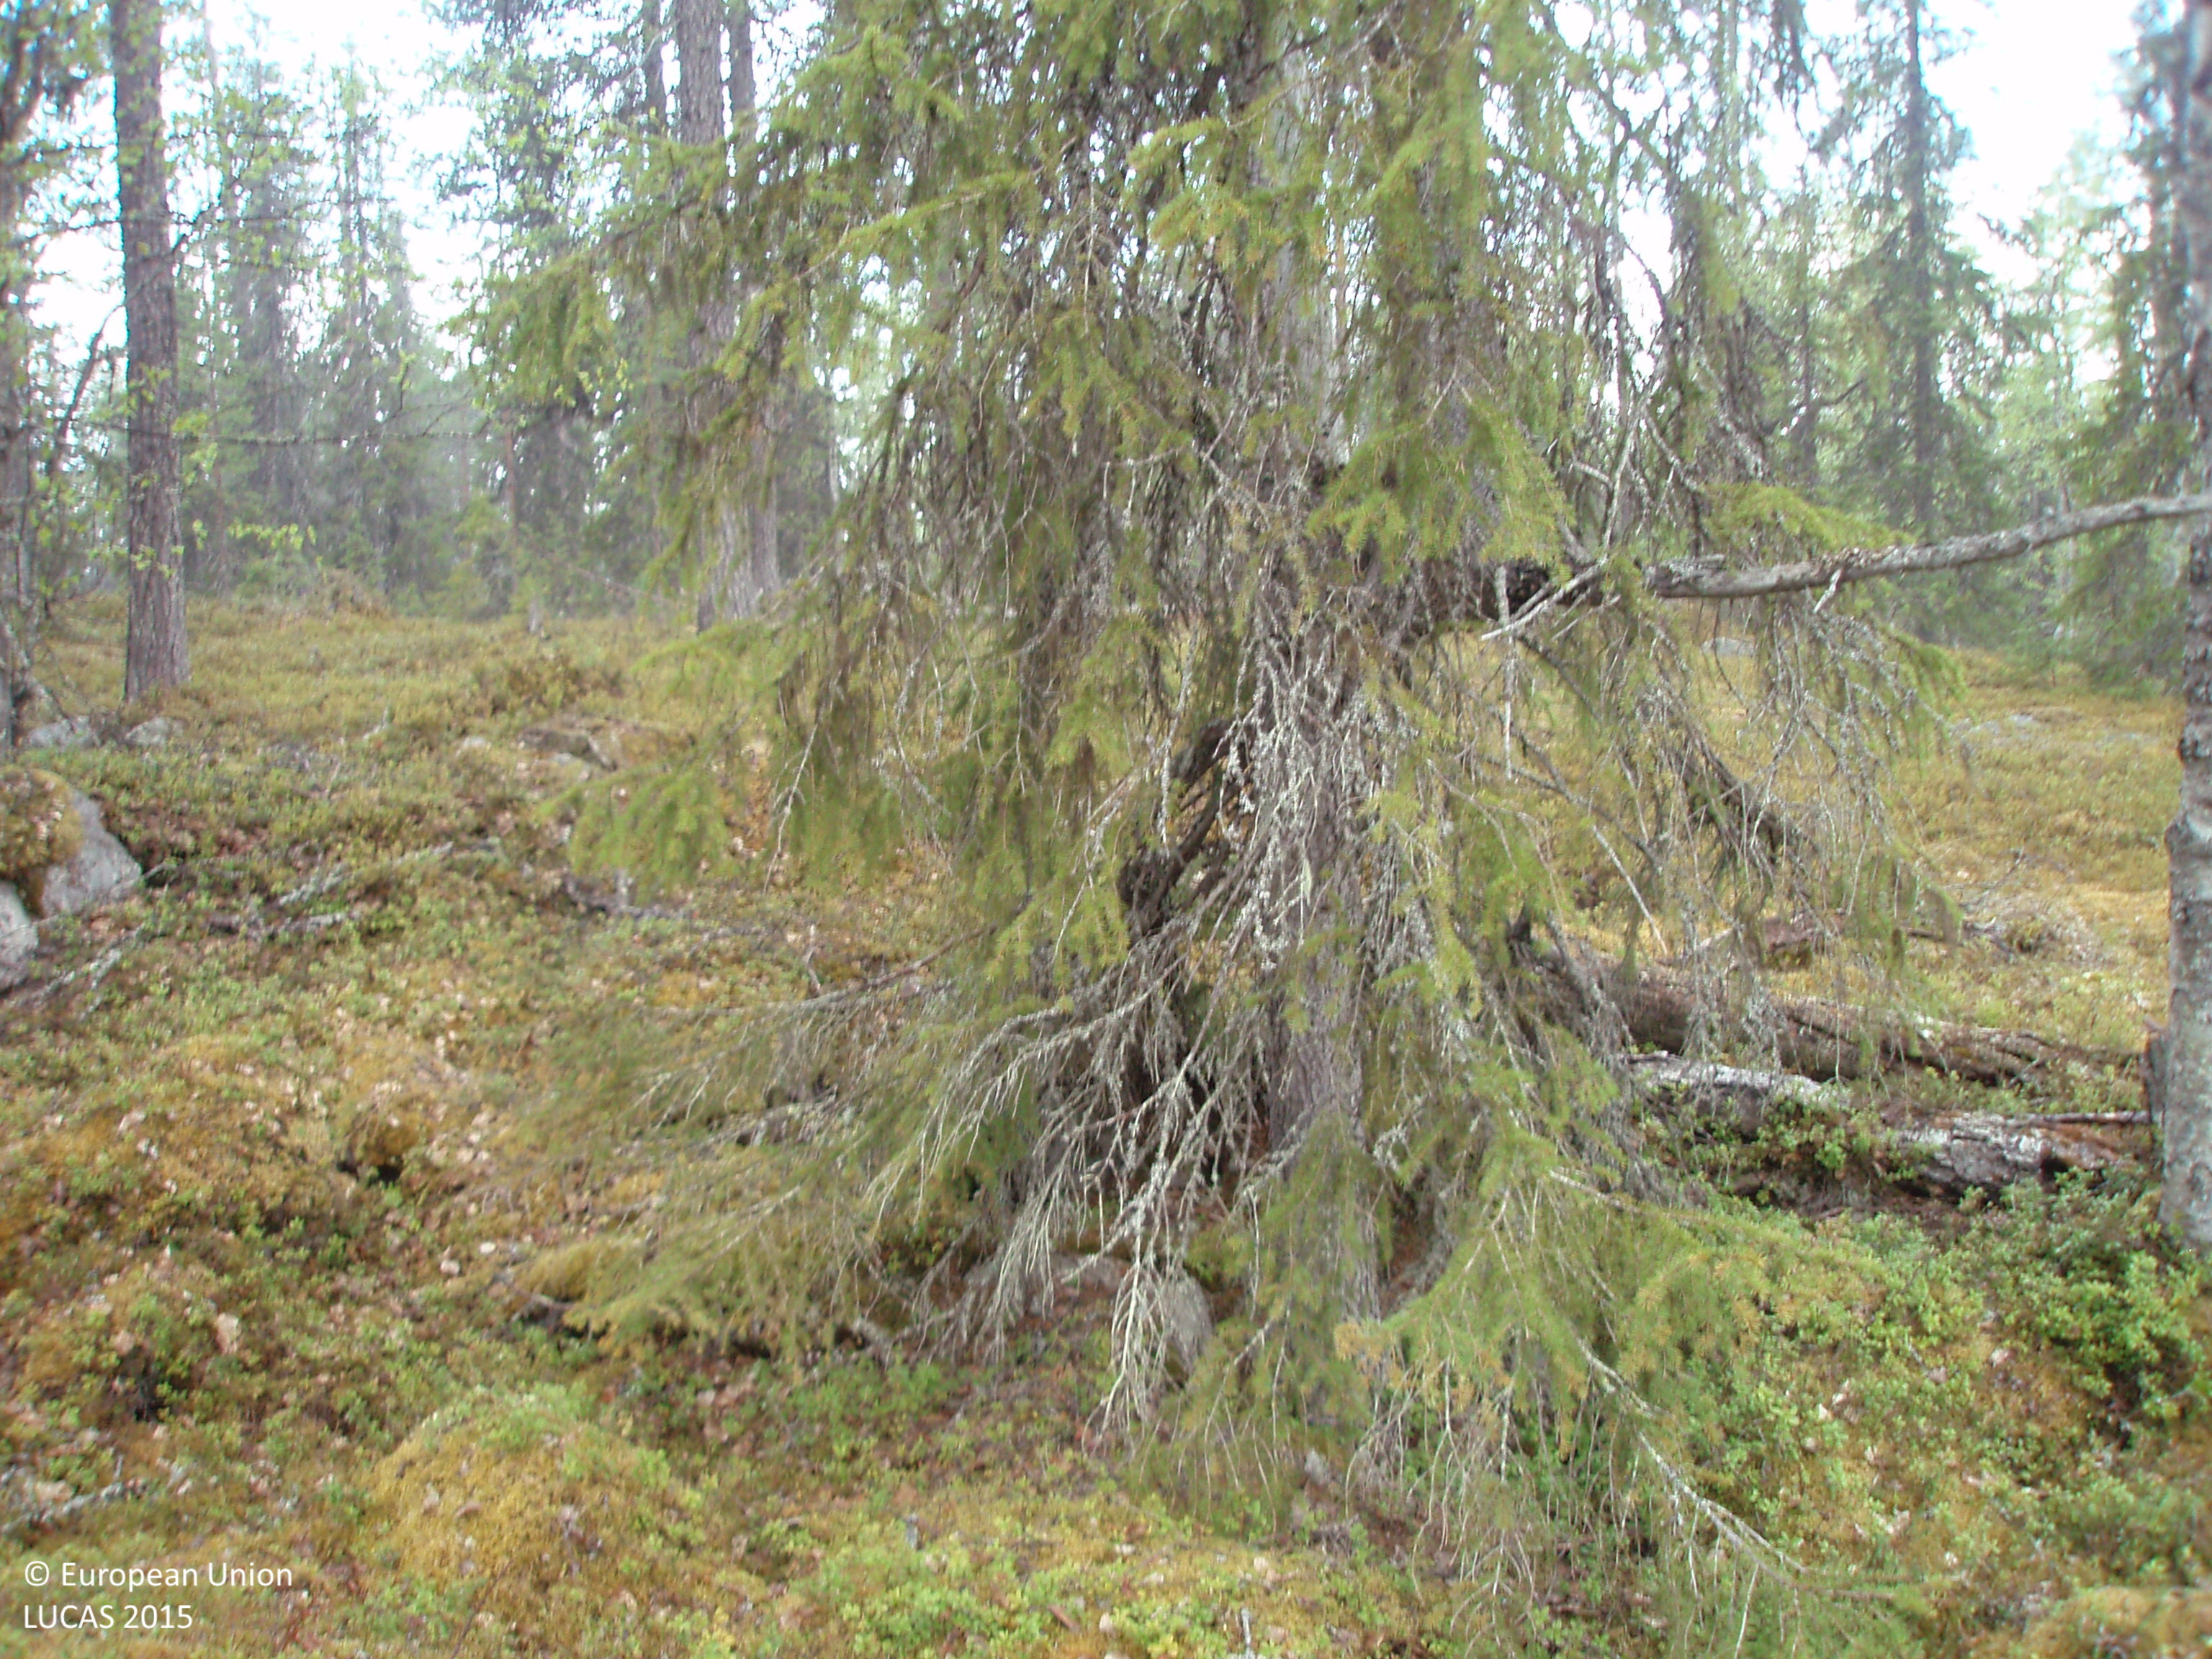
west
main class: Woodland
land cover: Other mixed woodland
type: boreal forest
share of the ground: 50 - 75 %
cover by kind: coniferous forest trees 40 %, shrubs 30 %, broadleaved forest trees 15 %, lichens and mosses 15 %
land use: Forestry
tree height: > 5 m
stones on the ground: < 10 %
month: June
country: FI
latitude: 67.1197
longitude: 26.9840
